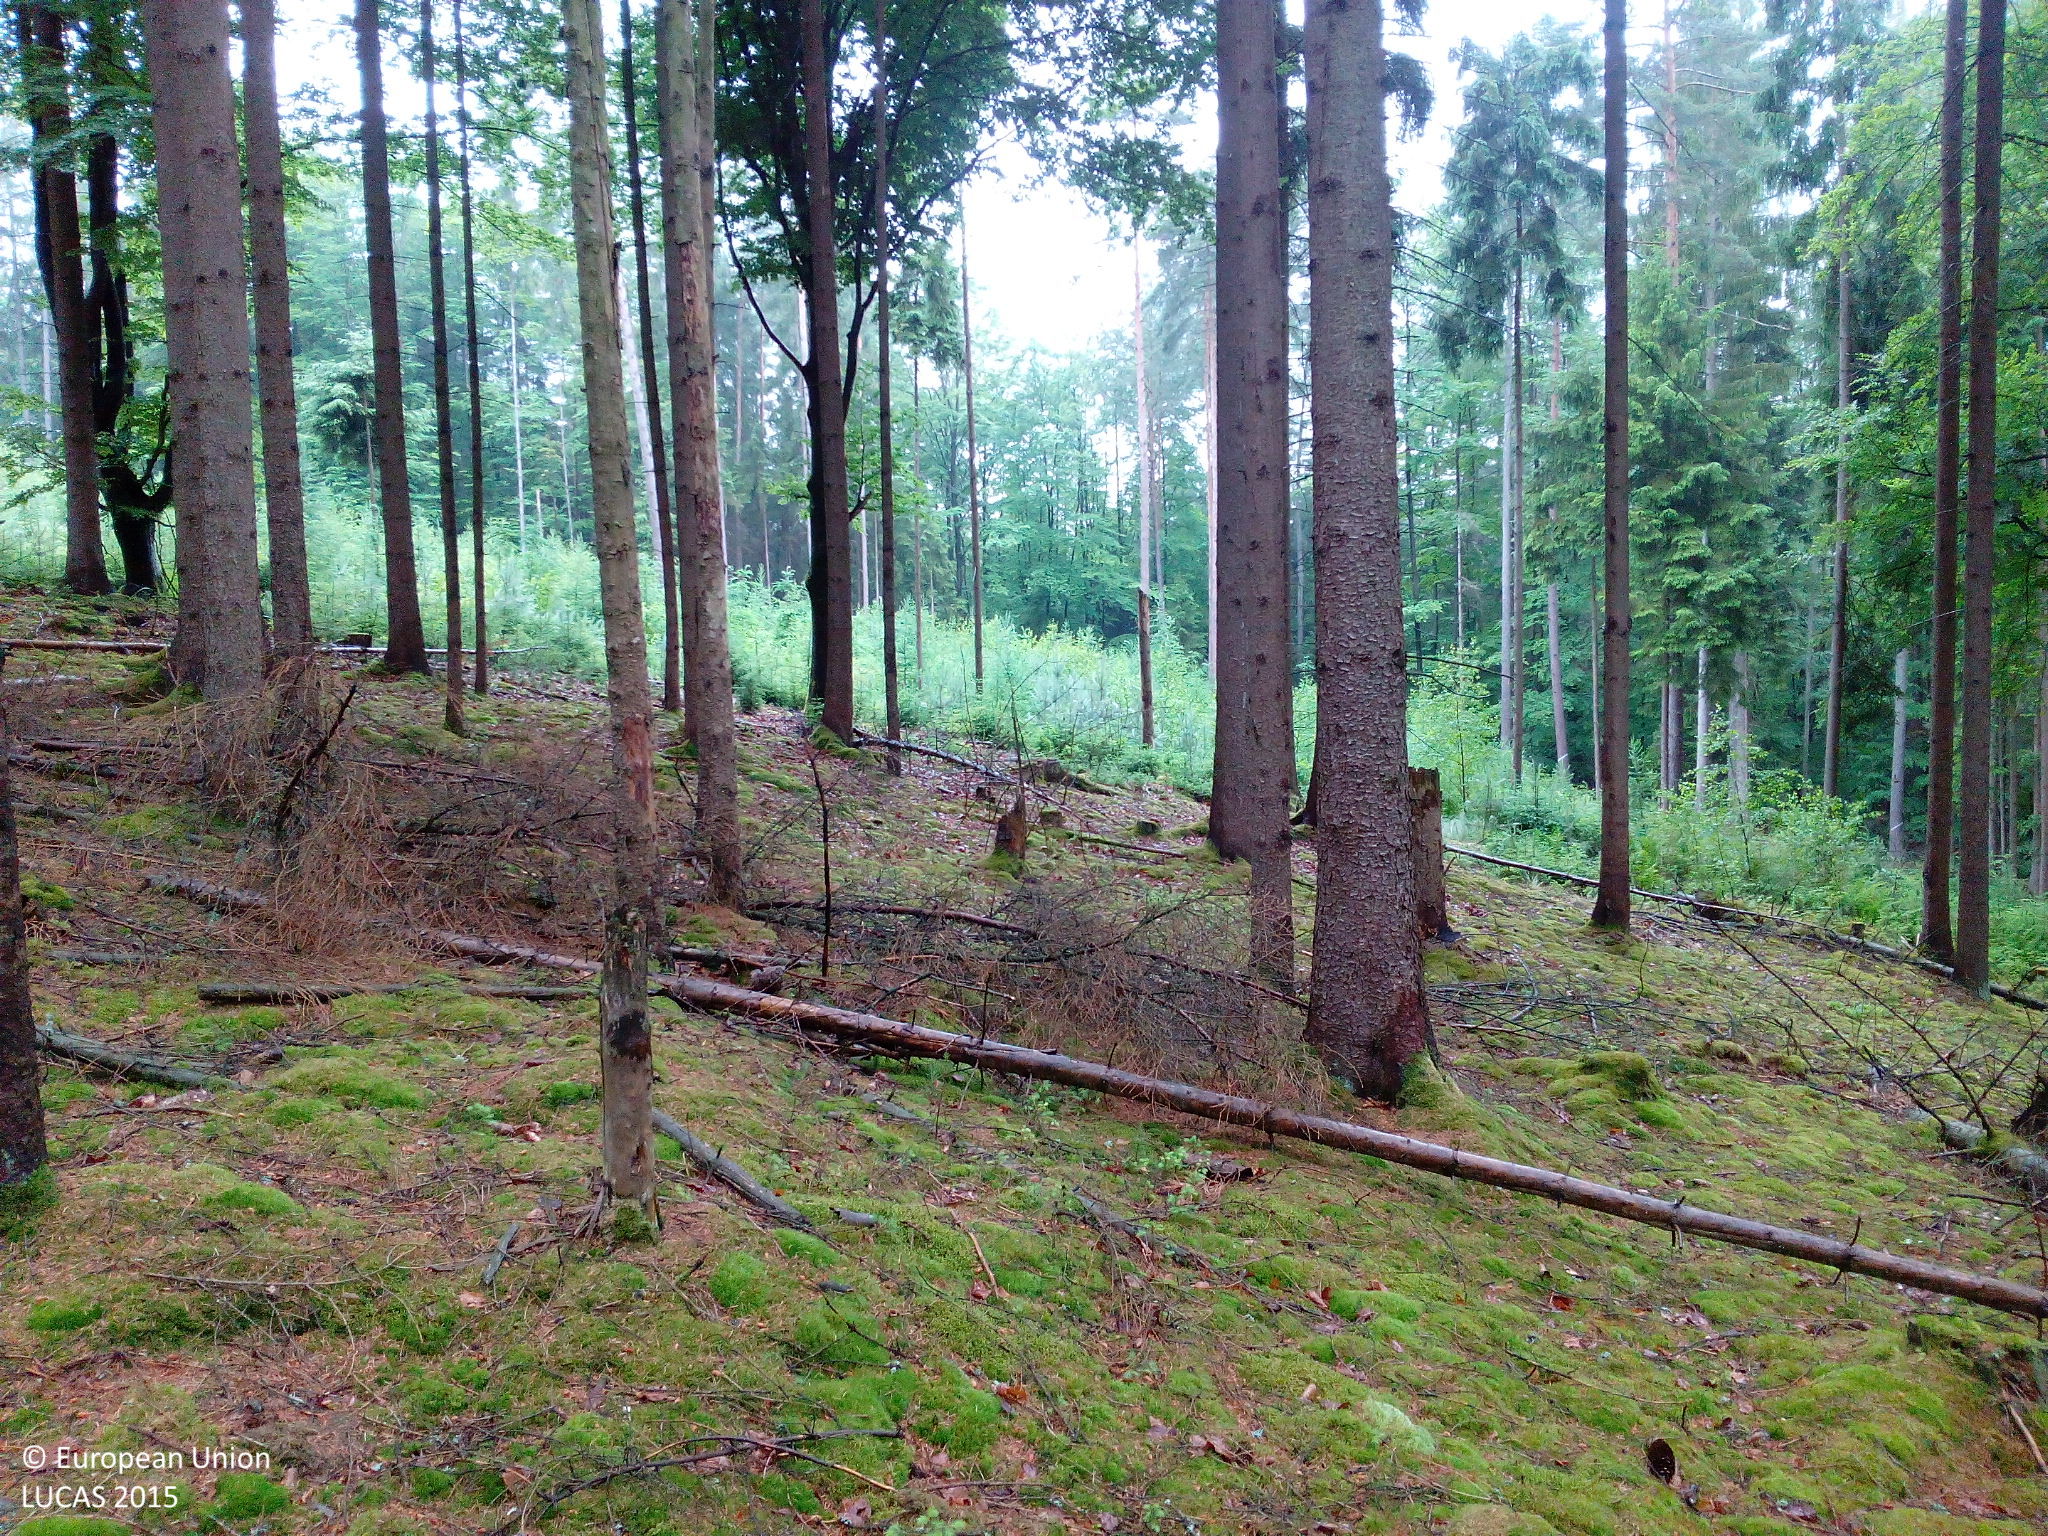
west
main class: Woodland
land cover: Spruce dominated coniferous woodland
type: hemiboreal forest and nemoral coniferous forest and mixed broadleaved-coniferous forest
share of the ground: 50 - 75 %
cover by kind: coniferous forest trees 55 %, herbaceous plants 20 %, lichens and mosses 20 %, broadleaved forest trees 5 %
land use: Forestry
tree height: > 5 m
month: June
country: DE
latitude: 50.1575
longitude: 11.4133
